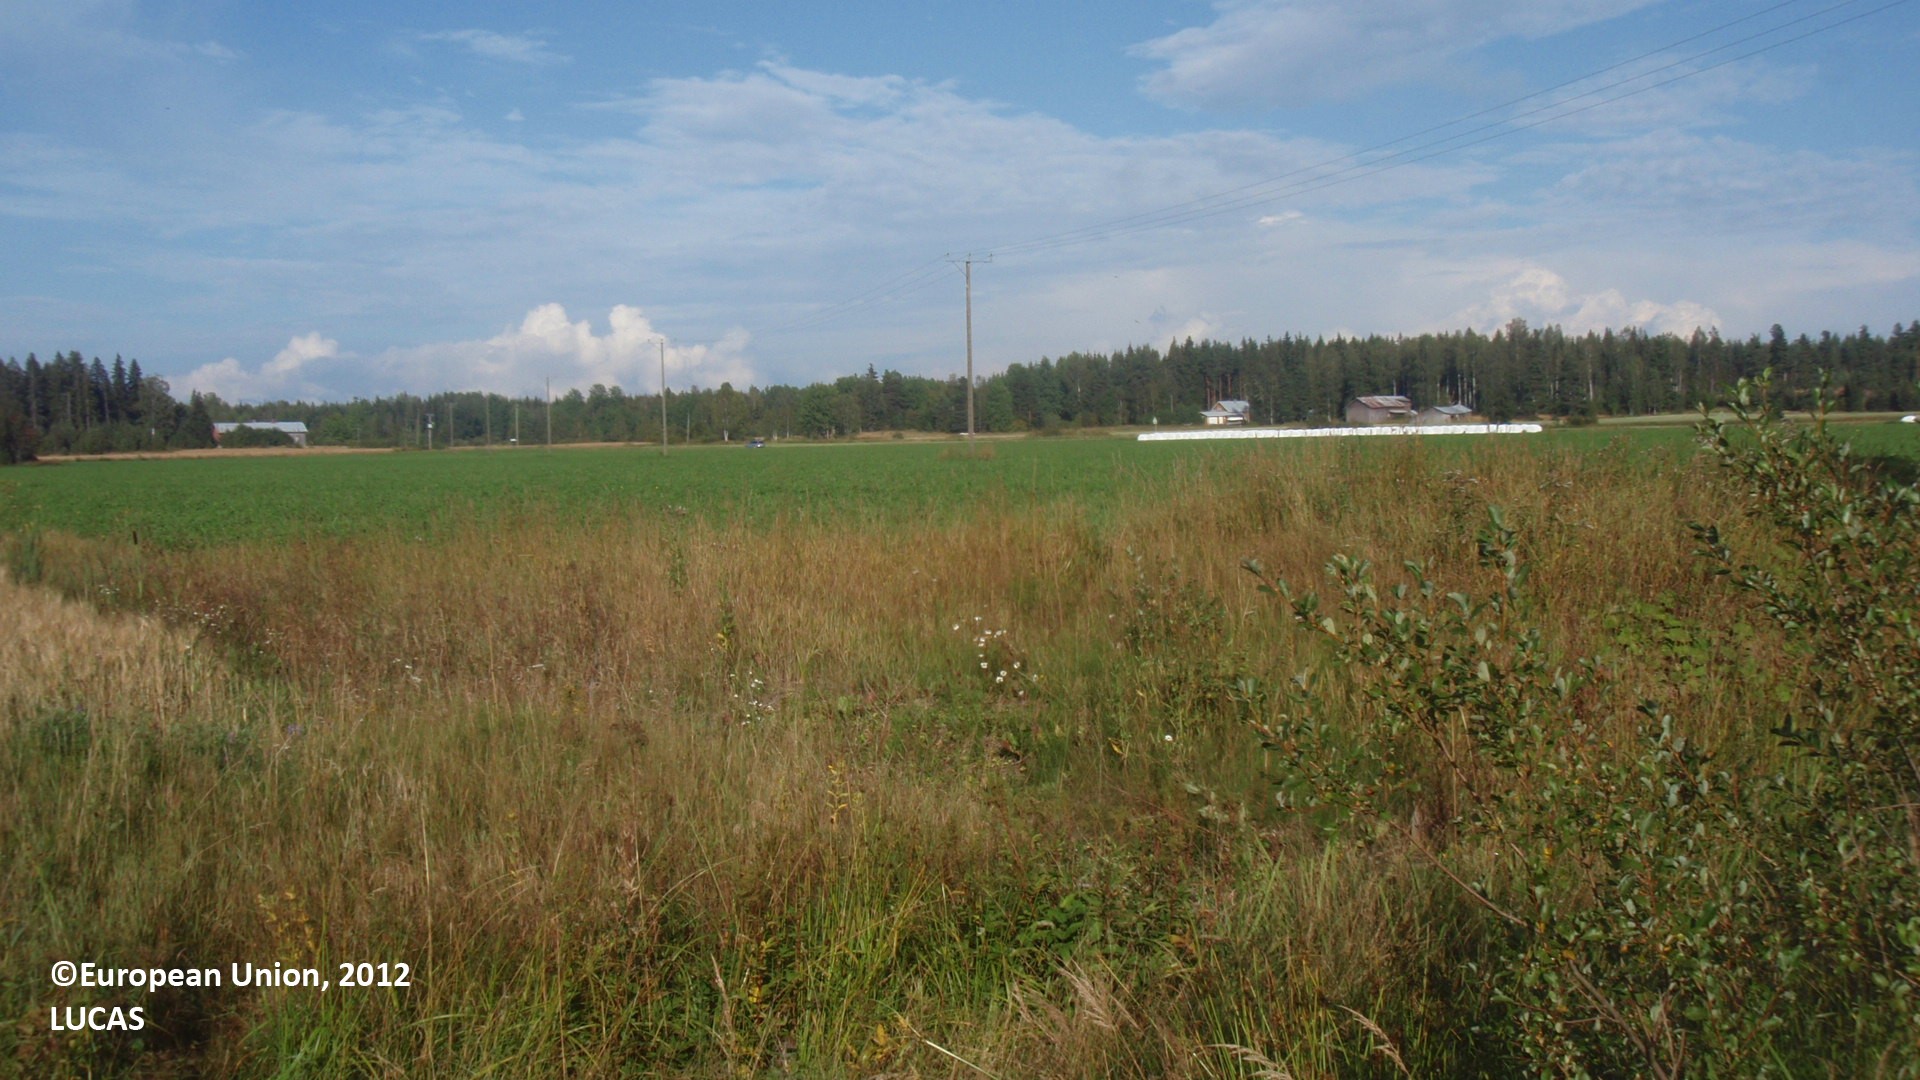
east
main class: Woodland
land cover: Broadleaved woodland
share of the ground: > 75 %
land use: Forestry
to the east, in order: Broadleaved woodland; Ditches and canals; Mixed cereals for fodder; Electric lines; Mixed cereals for fodder; Grass margins; Ditches and canals; Grass margins; Paved roads, cycling and walking lanes; Grass margins; Ditches and canals; Grassland without tree/shrub cover
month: August
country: FI
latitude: 60.6368
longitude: 26.6690
